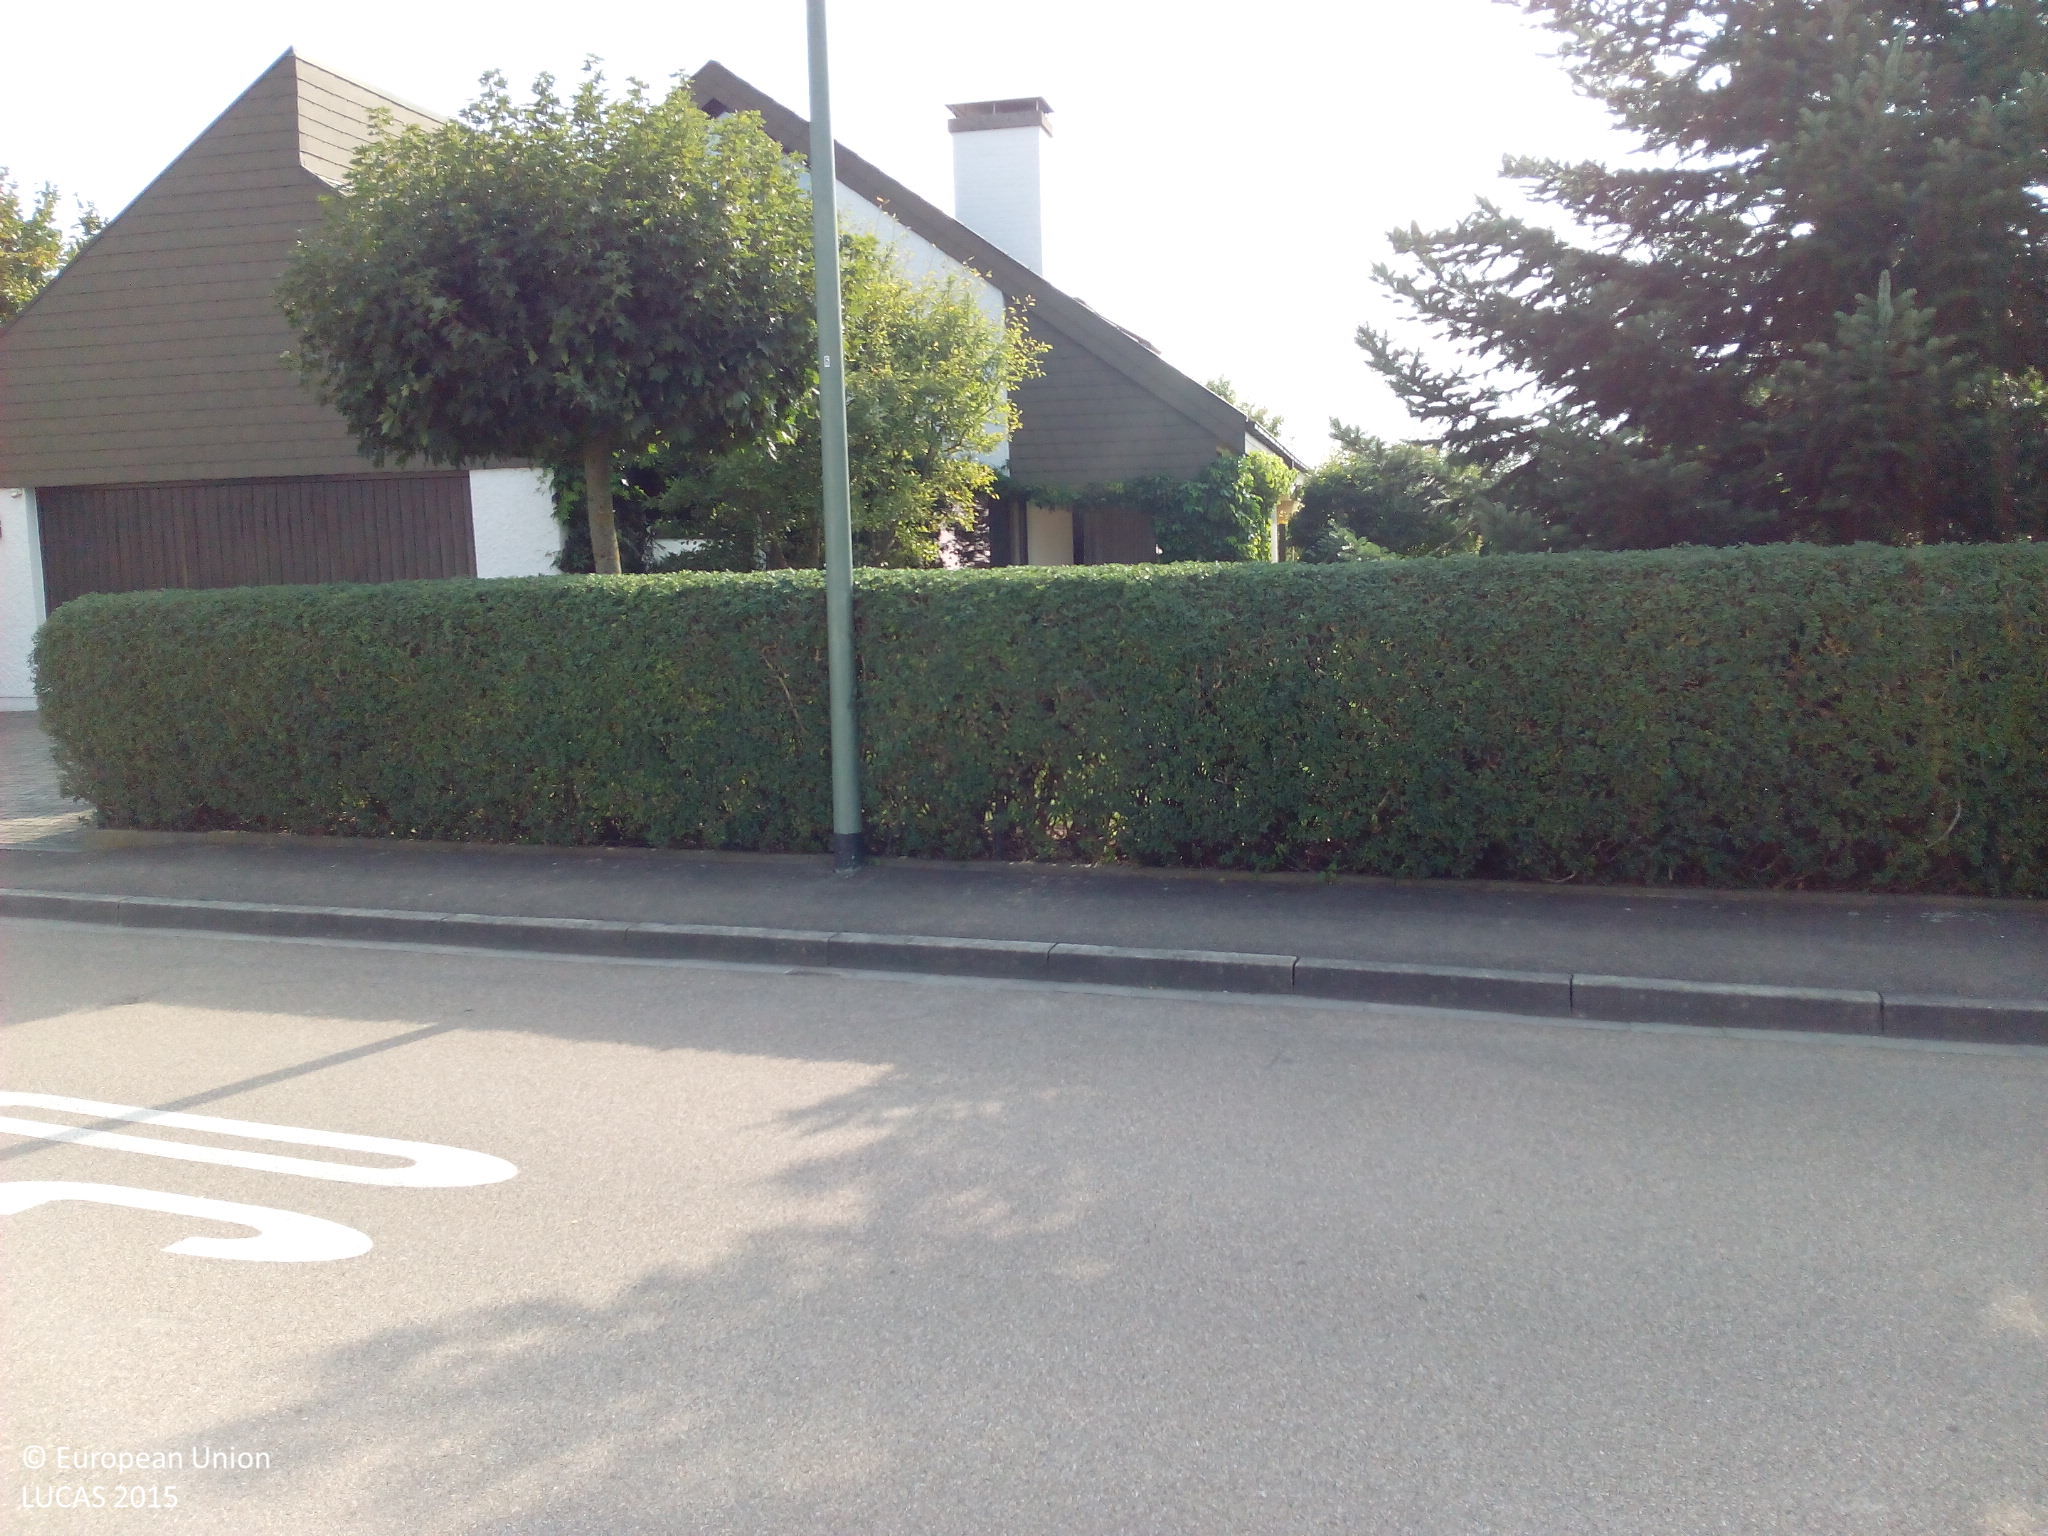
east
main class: Grassland
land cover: Grassland without tree/shrub cover
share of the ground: > 75 %
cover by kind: herbaceous plants 100 %
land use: Residential
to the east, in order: Grassland without tree/shrub cover; Artificial constructions in urban areas; Temporary grasslands
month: August
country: DE
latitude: 48.4570
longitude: 10.3108
